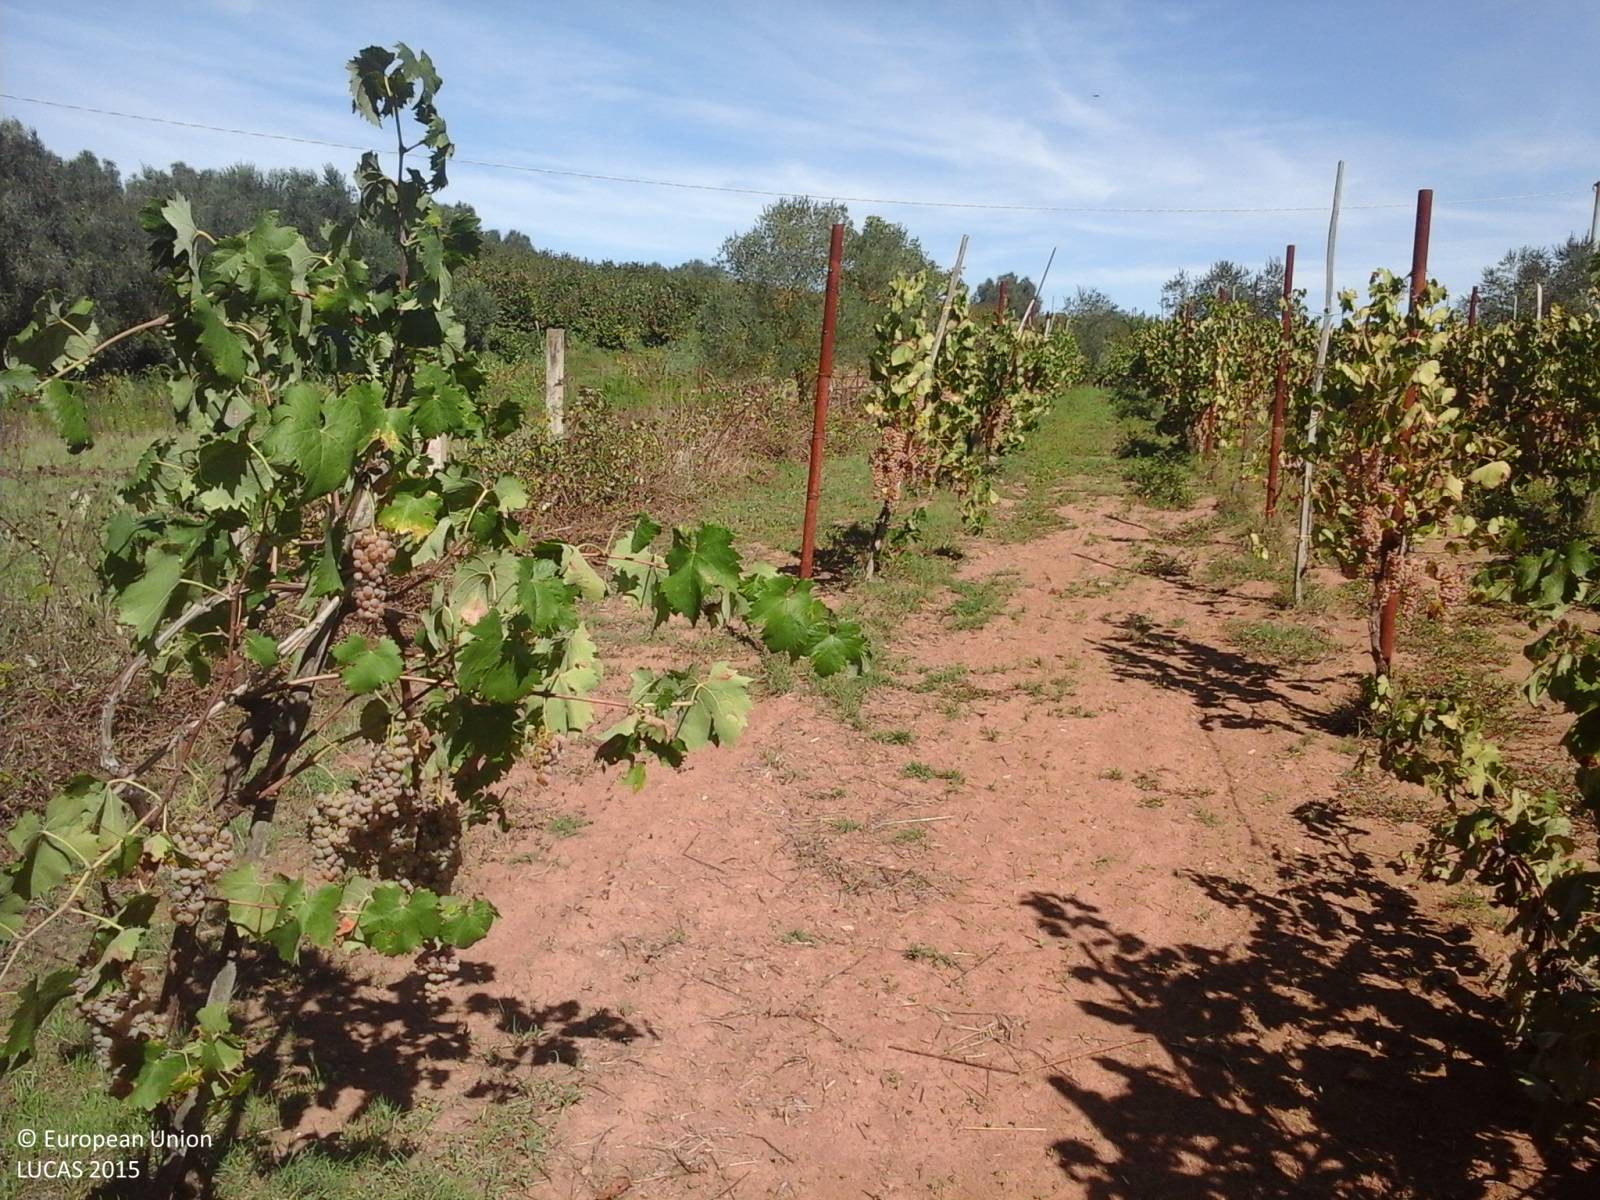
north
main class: Cropland
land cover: Vineyards
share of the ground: > 75 %
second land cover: Other bare soil
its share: > 75 %
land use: Agriculture (excluding fallow land and kitchen gardens)
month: September
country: IT
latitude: 42.3566
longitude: 12.3110
